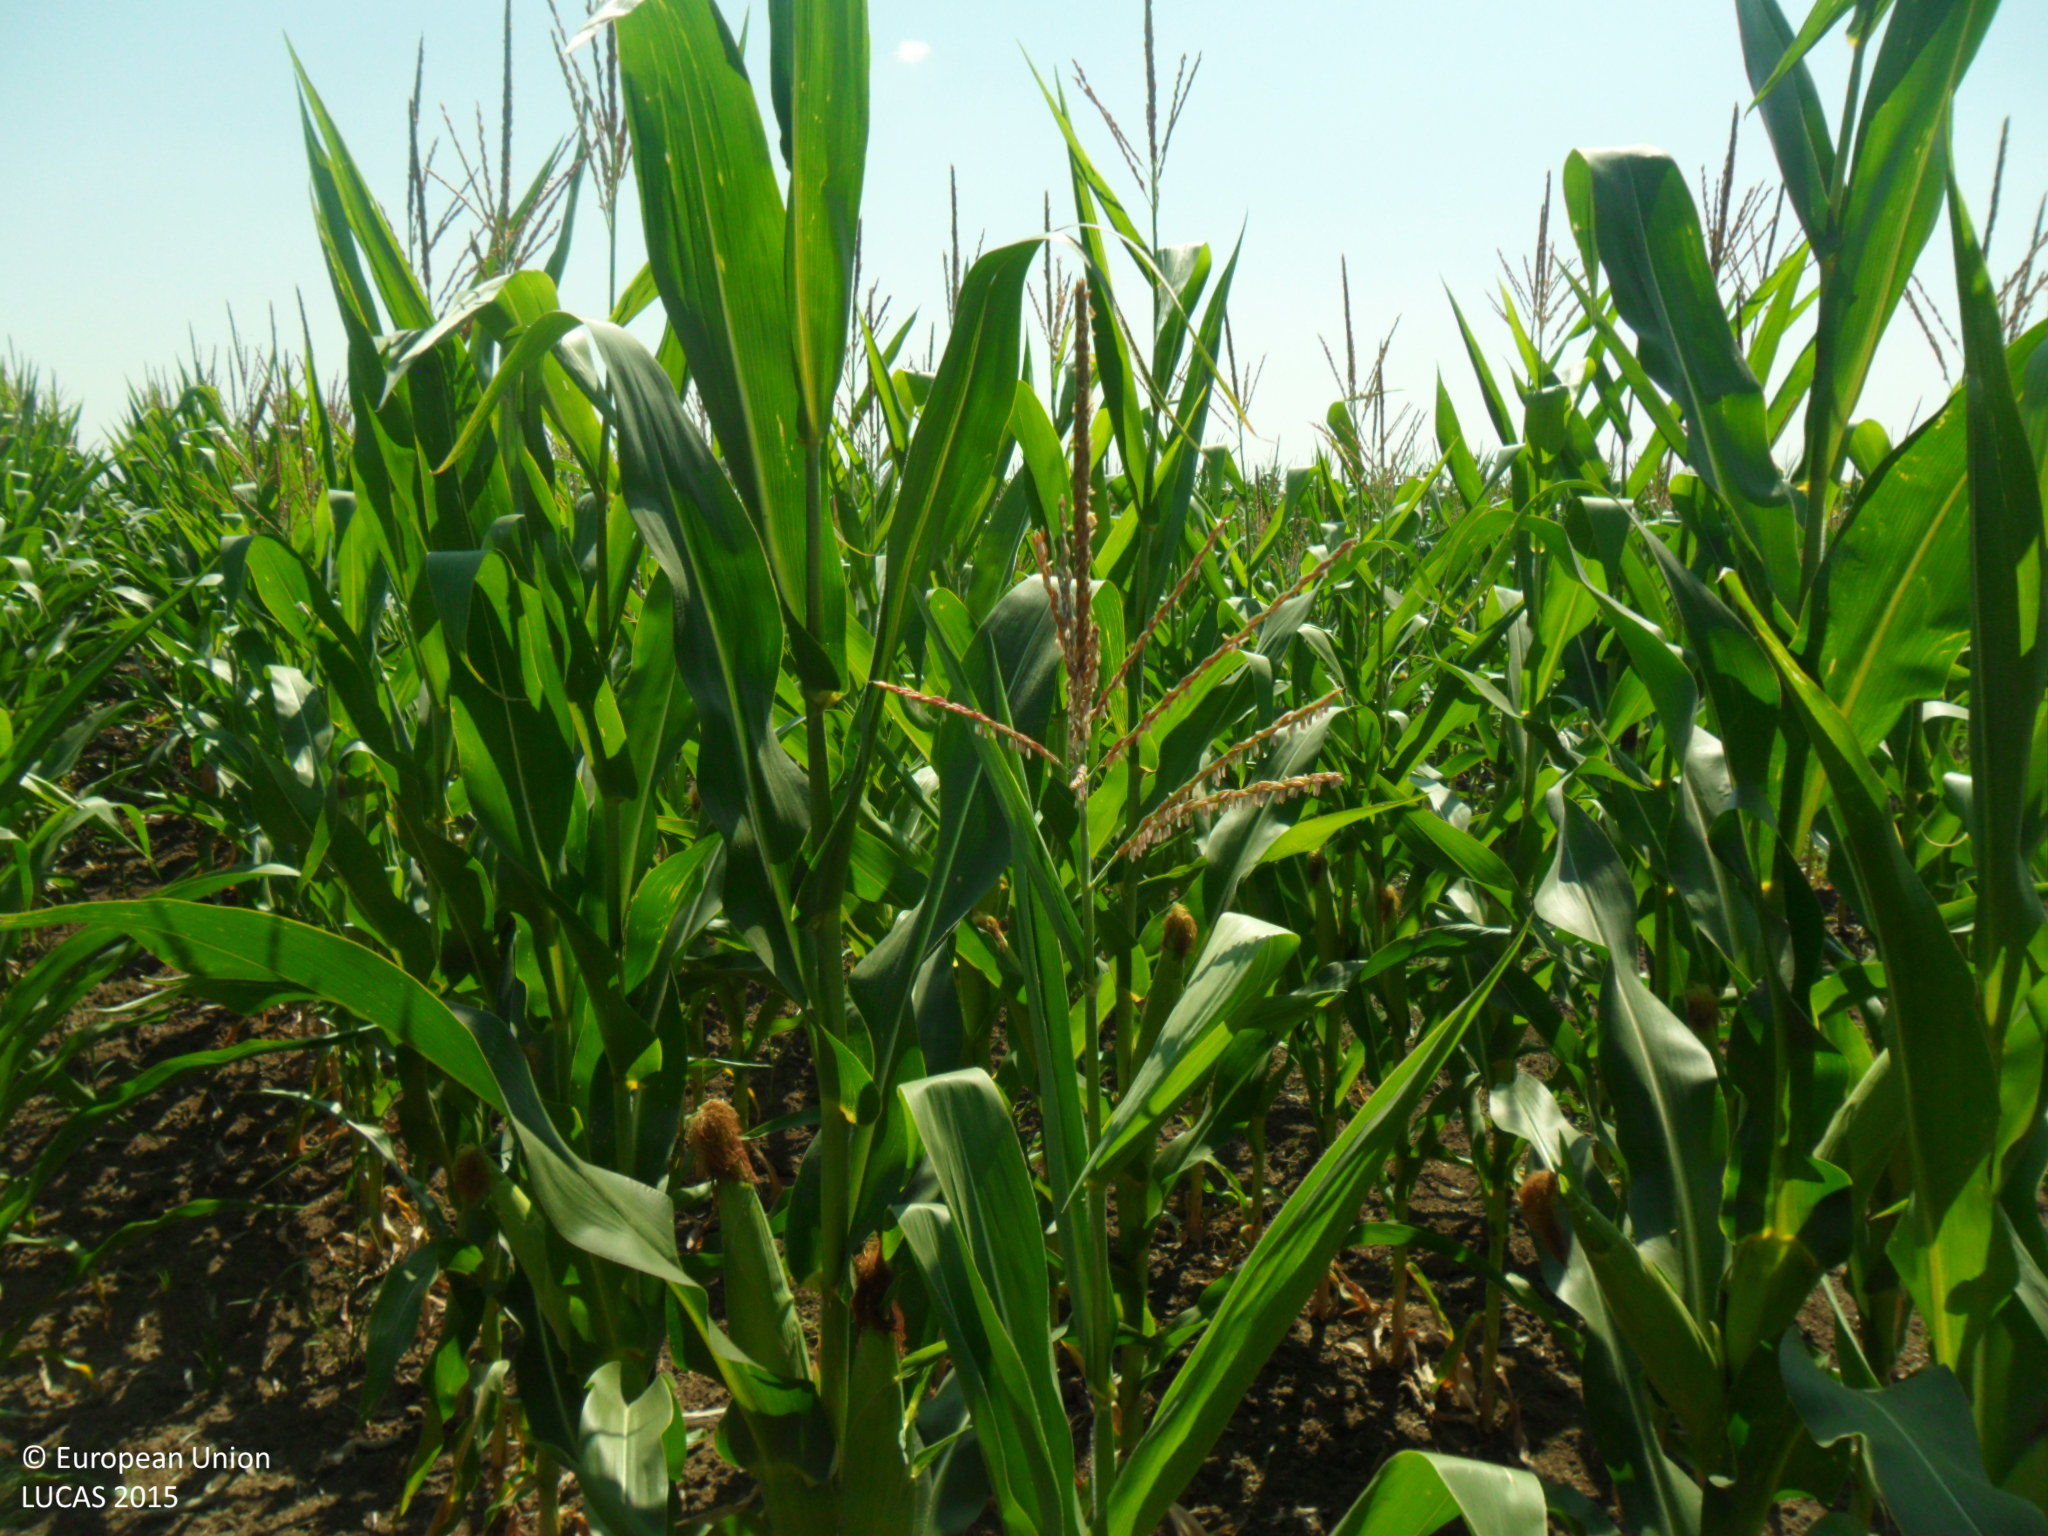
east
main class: Cropland
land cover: Maize
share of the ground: > 75 %
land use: Agriculture (excluding fallow land and kitchen gardens)
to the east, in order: Maize
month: July
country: BG
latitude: 43.6005
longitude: 27.3092
